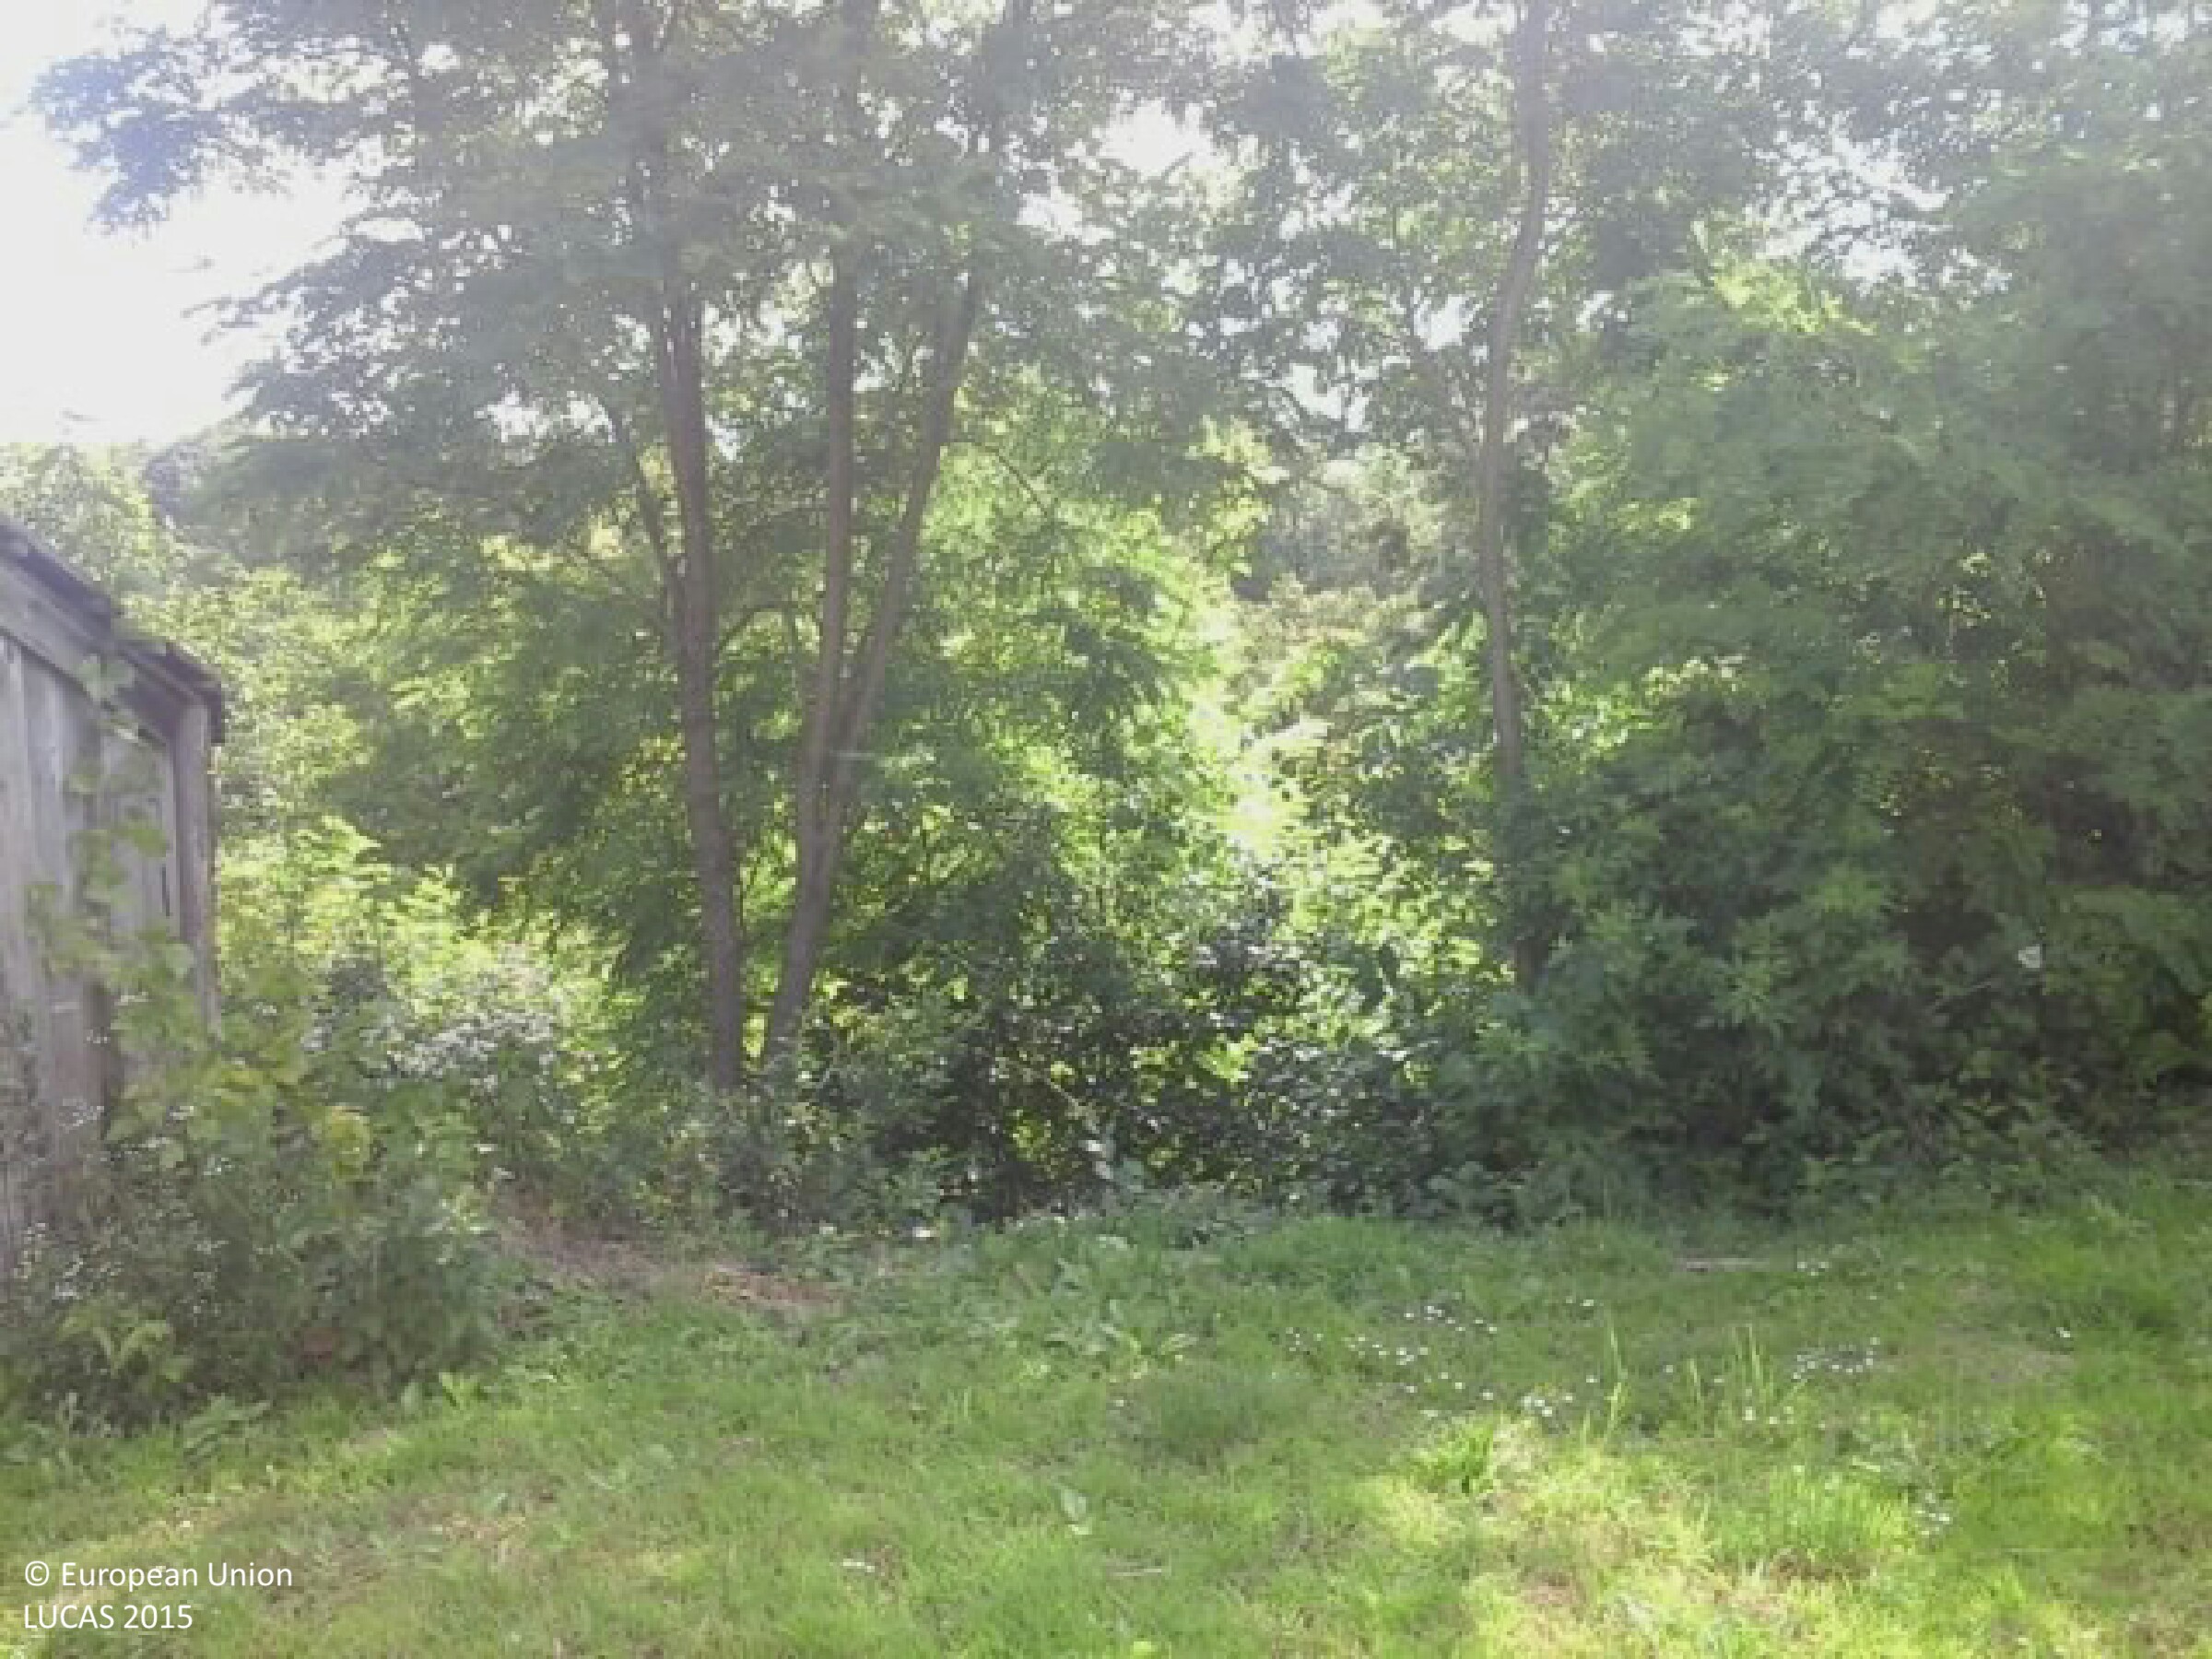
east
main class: Grassland
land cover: Grassland without tree/shrub cover
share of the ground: > 75 %
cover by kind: herbaceous plants 100 %
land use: Agriculture (excluding fallow land and kitchen gardens)
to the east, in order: Grassland without tree/shrub cover; Broadleaved woodland; Grassland without tree/shrub cover; Artificial constructions in urban areas; Grassland without tree/shrub cover; Broadleaved woodland
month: June
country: HU
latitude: 46.3506
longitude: 17.8680
